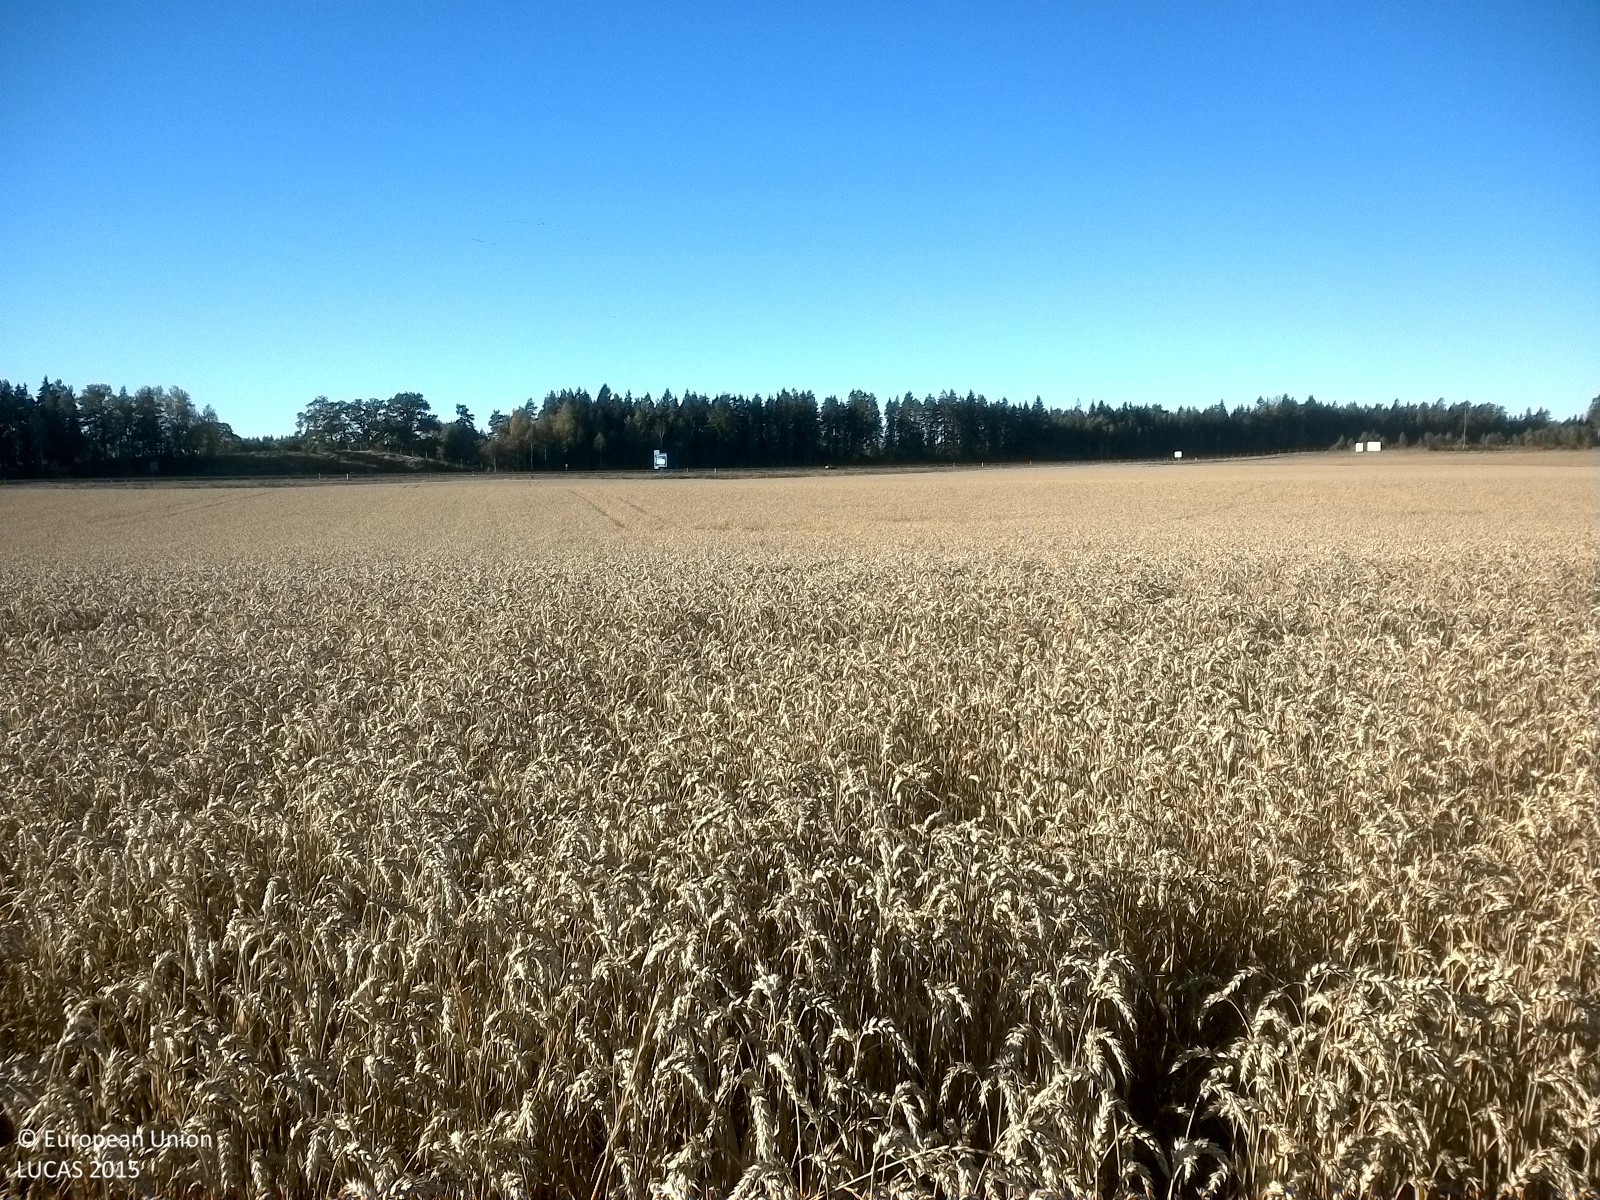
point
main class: Cropland
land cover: Common wheat
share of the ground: > 75 %
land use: Agriculture (excluding fallow land and kitchen gardens)
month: September
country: SE
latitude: 58.7540
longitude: 16.7541
